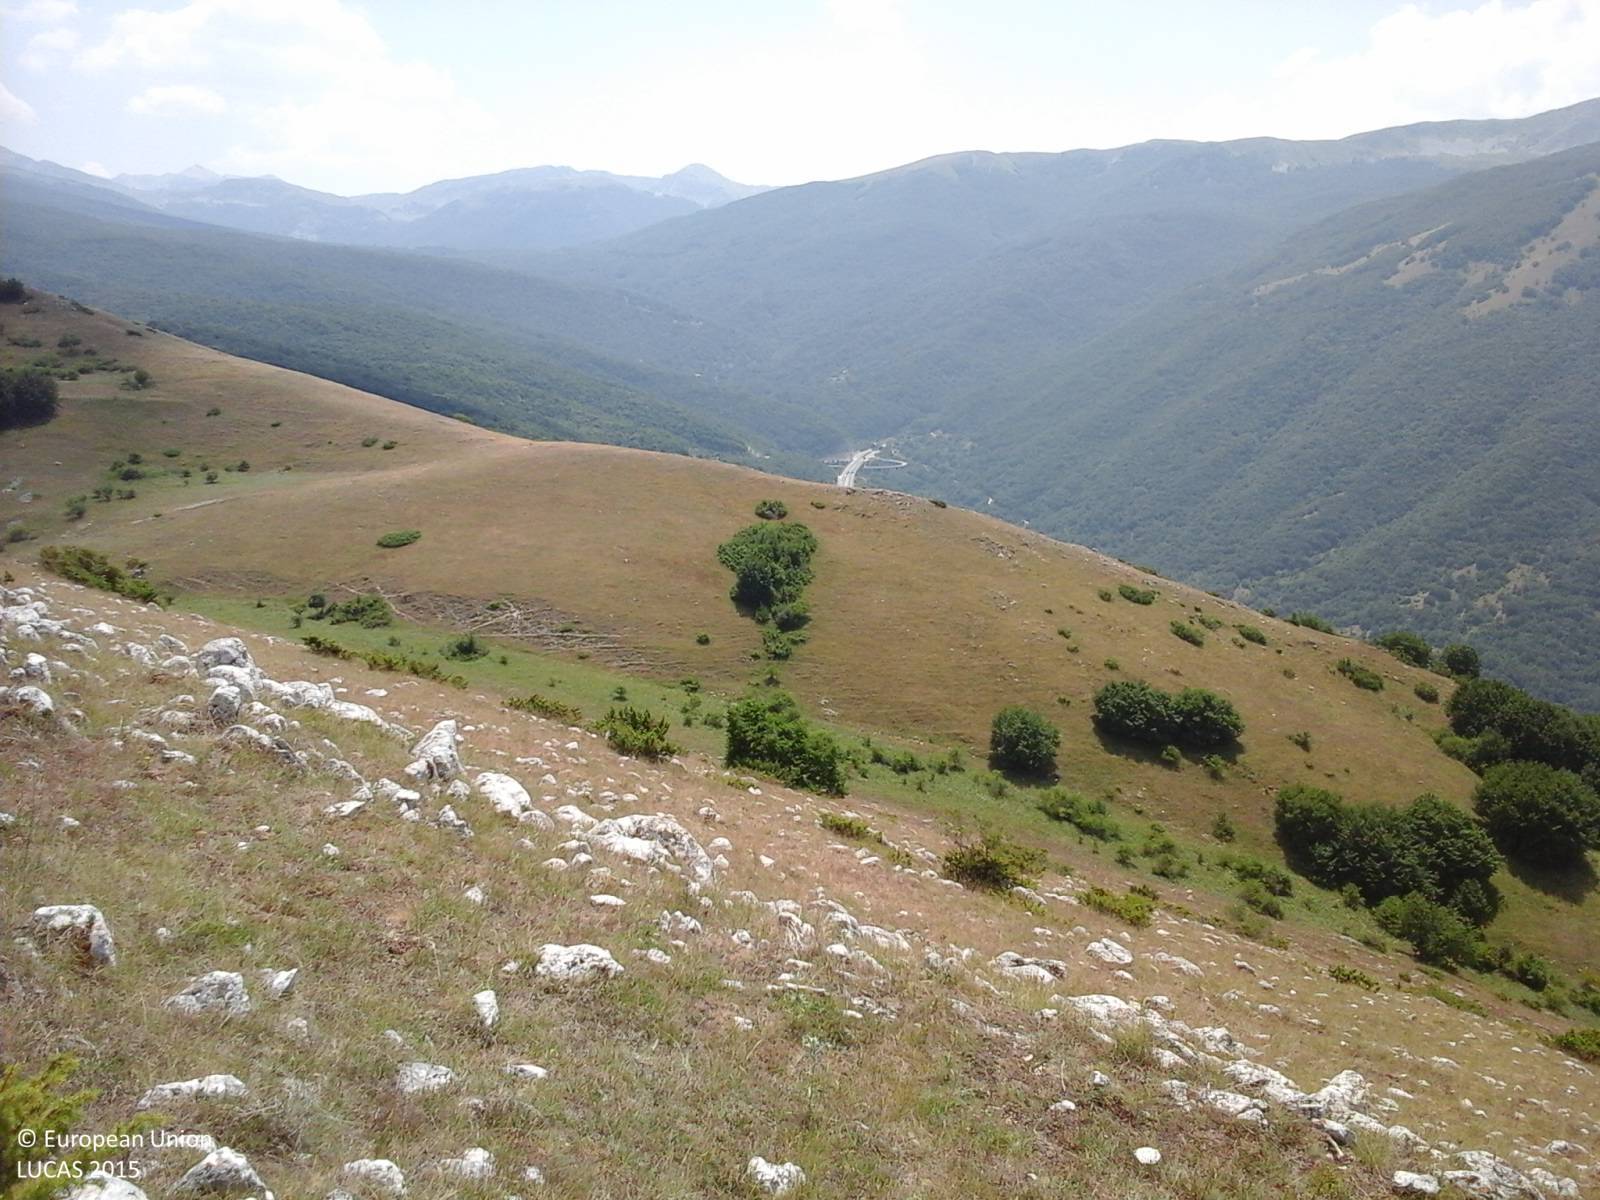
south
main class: Grassland
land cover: Grassland without tree/shrub cover
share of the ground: > 75 %
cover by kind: herbaceous plants 60 %, consolidated bare surface 40 %
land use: Agriculture (excluding fallow land and kitchen gardens)
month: July
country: IT
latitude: 42.2741
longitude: 13.3234
